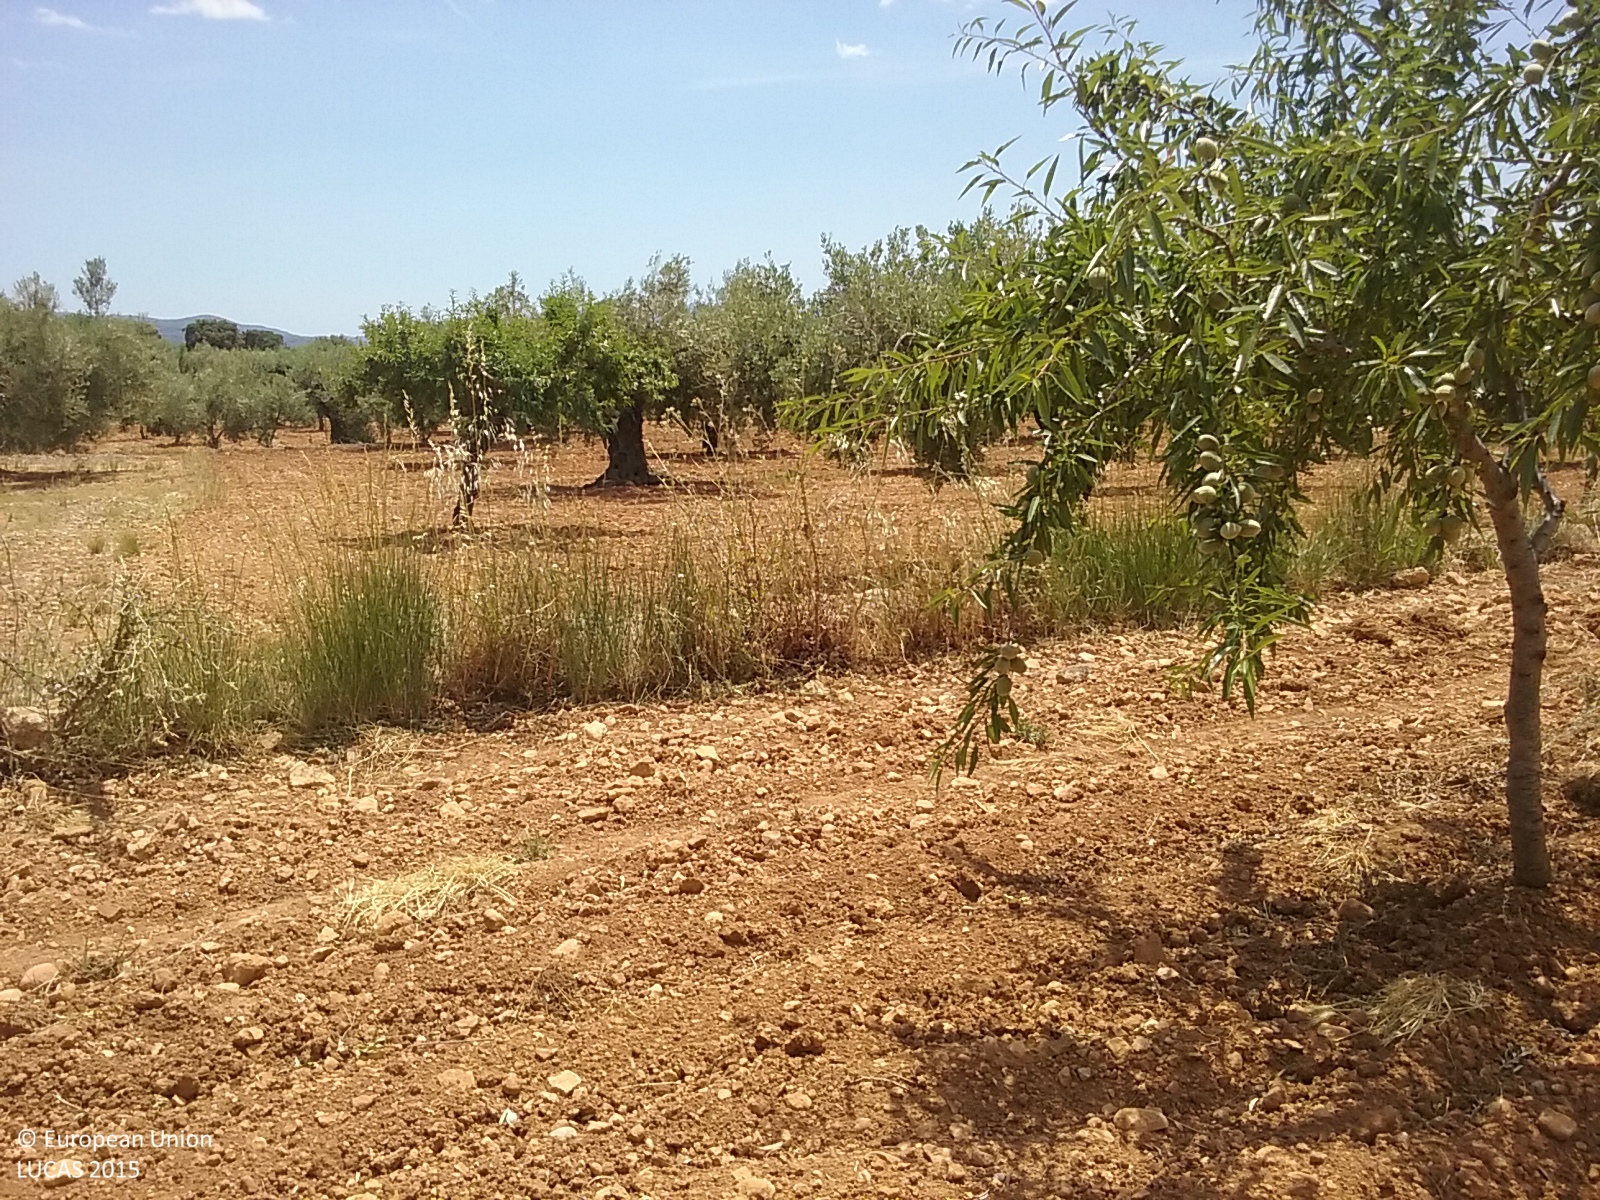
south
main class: Cropland
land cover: Nuts trees
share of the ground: 10 - 25 %
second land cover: Other bare soil
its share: > 75 %
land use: Agriculture (excluding fallow land and kitchen gardens)
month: May
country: ES
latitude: 40.2307
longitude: 0.0187
